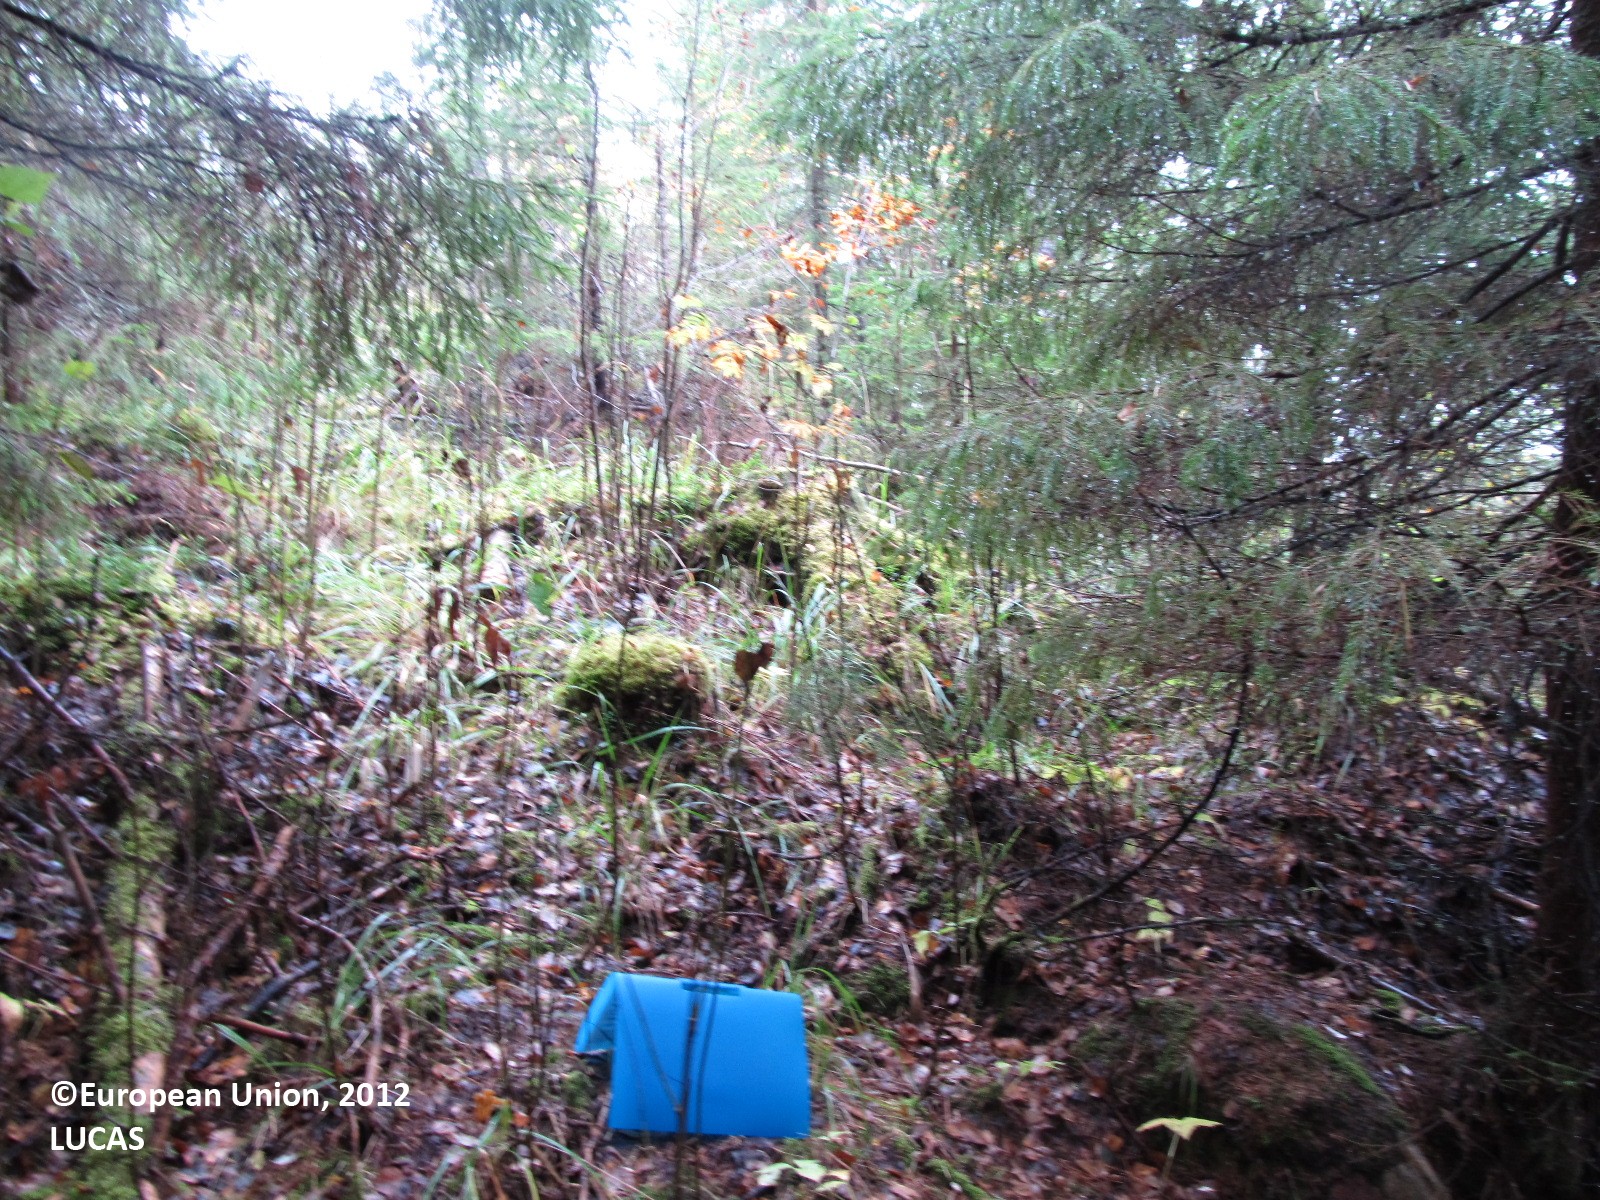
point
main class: Woodland
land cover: Spruce dominated coniferous woodland
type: boreal forest
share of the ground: 50 - 75 %
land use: Forestry
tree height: > 5 m
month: September
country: FI
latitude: 62.5739
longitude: 27.9890
